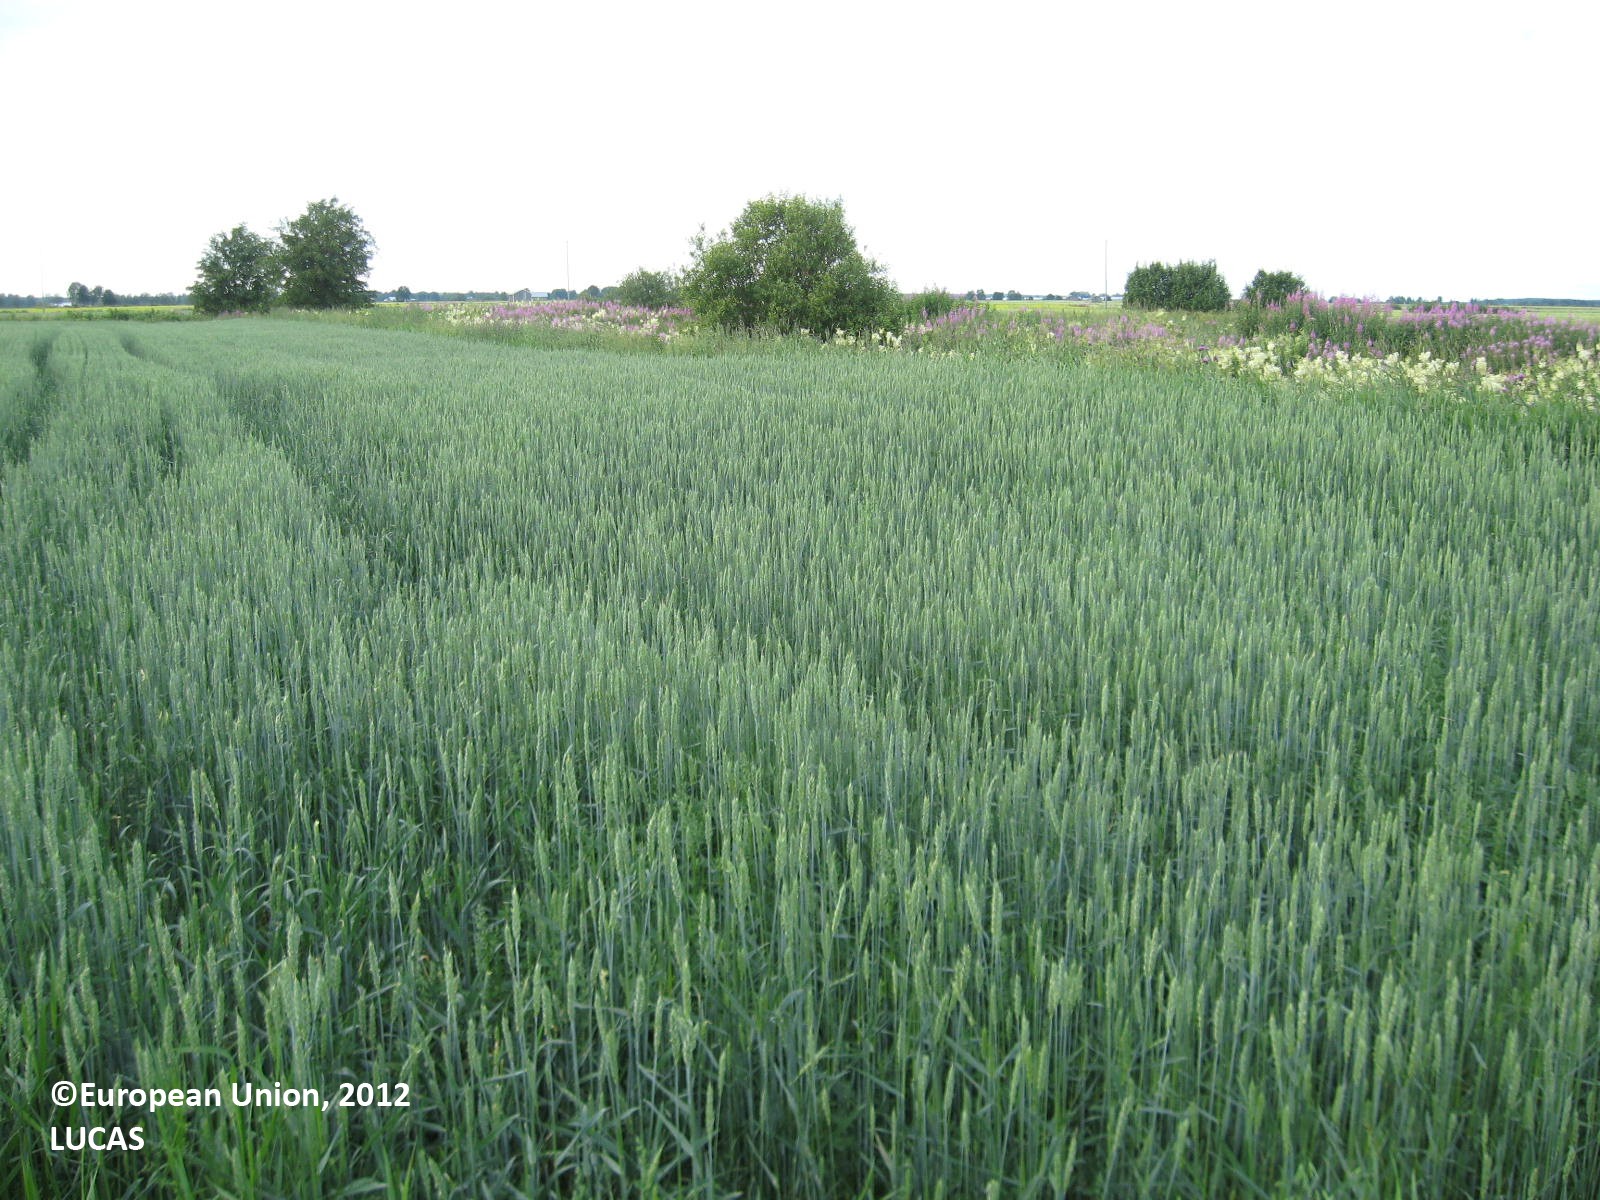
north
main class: Cropland
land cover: Barley
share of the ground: > 75 %
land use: Agriculture (excluding fallow land and kitchen gardens)
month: July
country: FI
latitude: 62.5745
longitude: 21.4661
